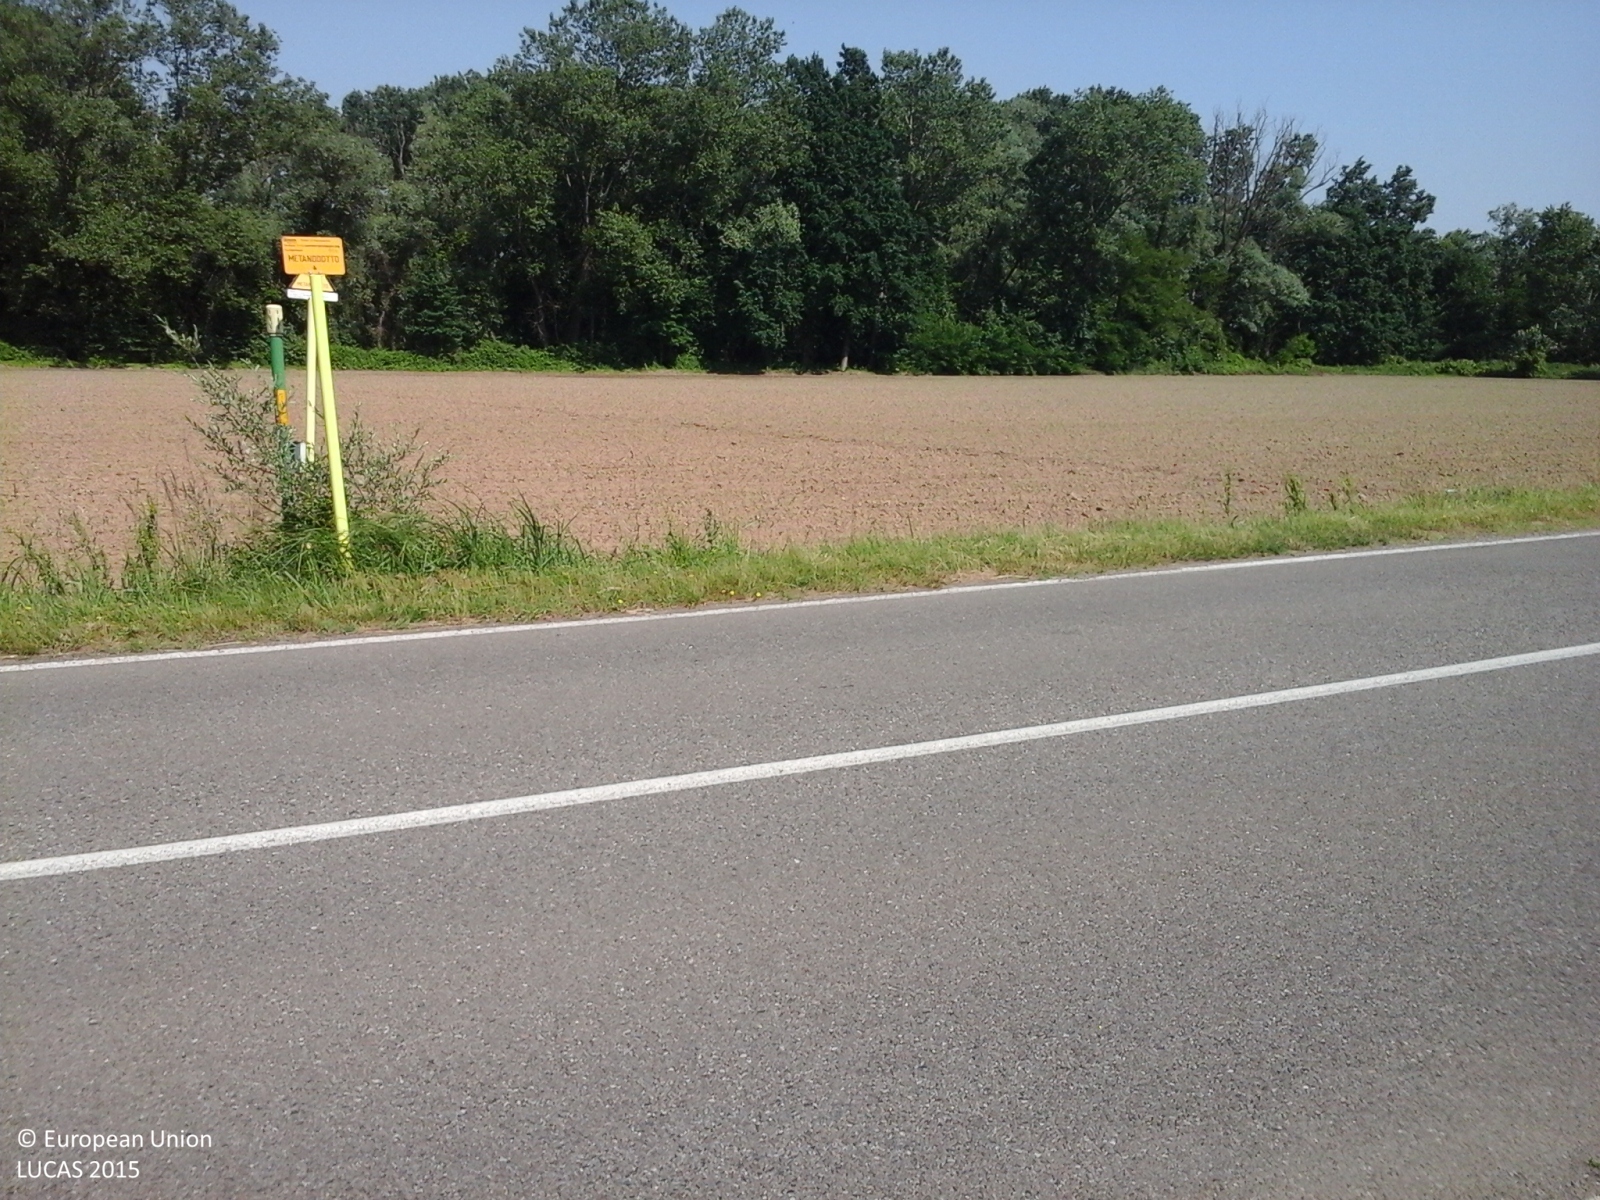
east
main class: Cropland
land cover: Rice
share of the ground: 50 - 75 %
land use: Agriculture (excluding fallow land and kitchen gardens)
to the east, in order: Rice; Grass margins; Tracks; Grass margins; Abandoned hedges; Ditches and canals; Grass margins; Paved roads, cycling and walking lanes; Maize; Broadleaved woodland
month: May
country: IT
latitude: 45.3023
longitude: 9.0962
